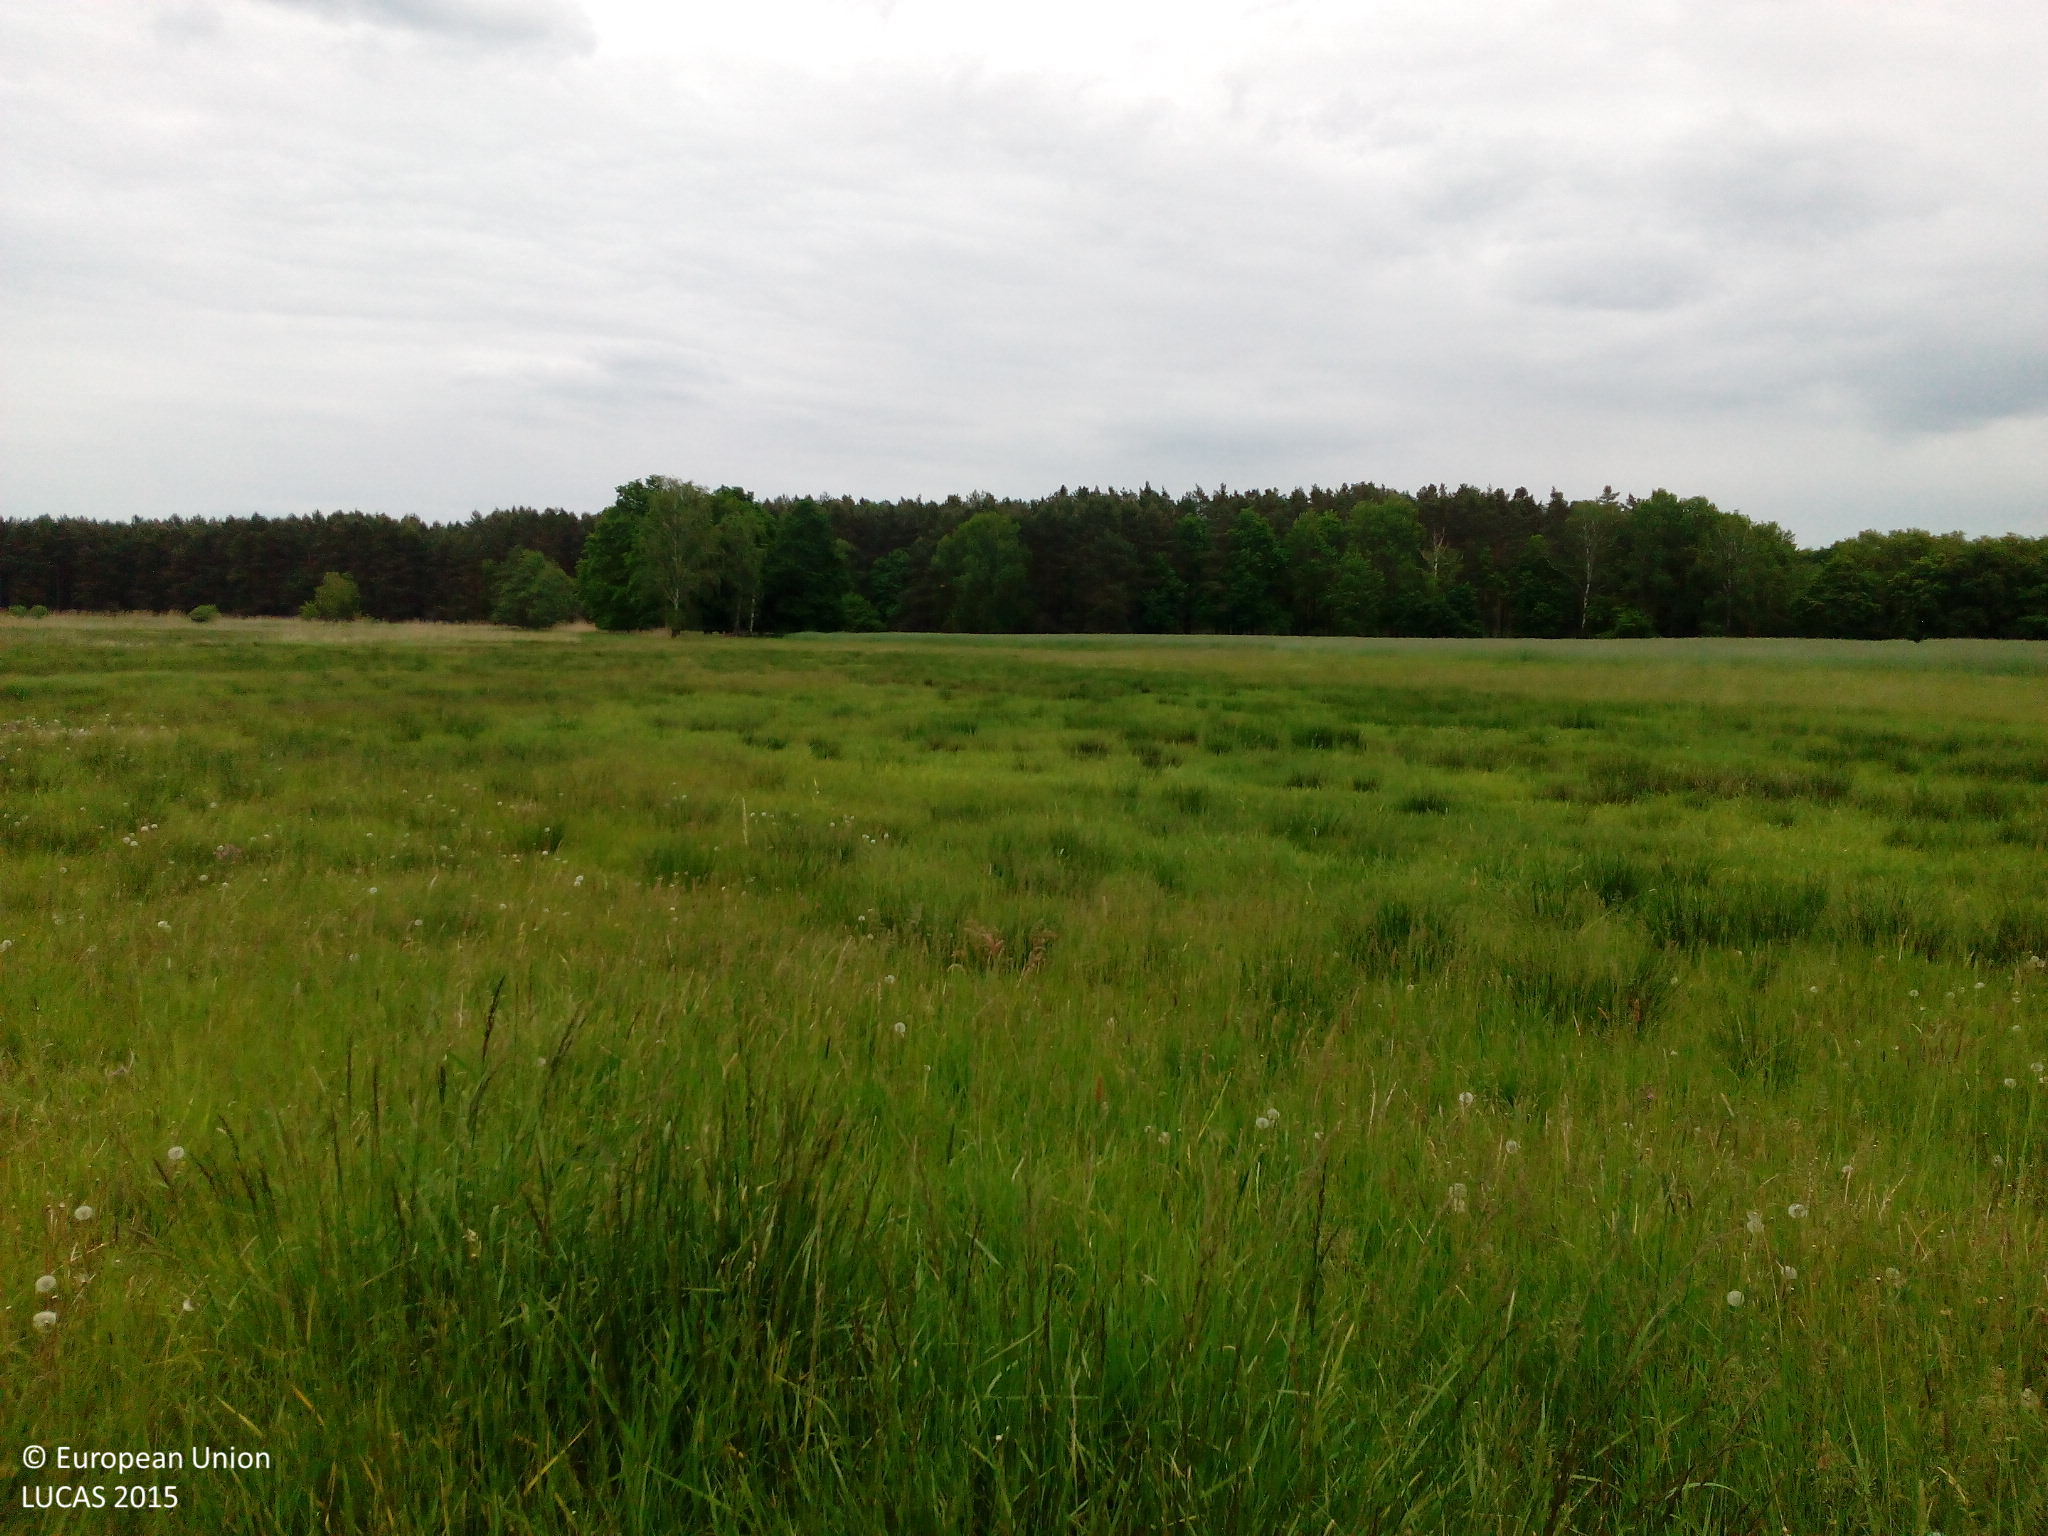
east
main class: Grassland
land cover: Grassland without tree/shrub cover
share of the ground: > 75 %
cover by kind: herbaceous plants 100 %
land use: Agriculture (excluding fallow land and kitchen gardens)
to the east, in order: Grassland without tree/shrub cover; Rye; Grassland without tree/shrub cover; Pine dominated mixed woodland
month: May
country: DE
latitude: 51.7687
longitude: 14.0440
